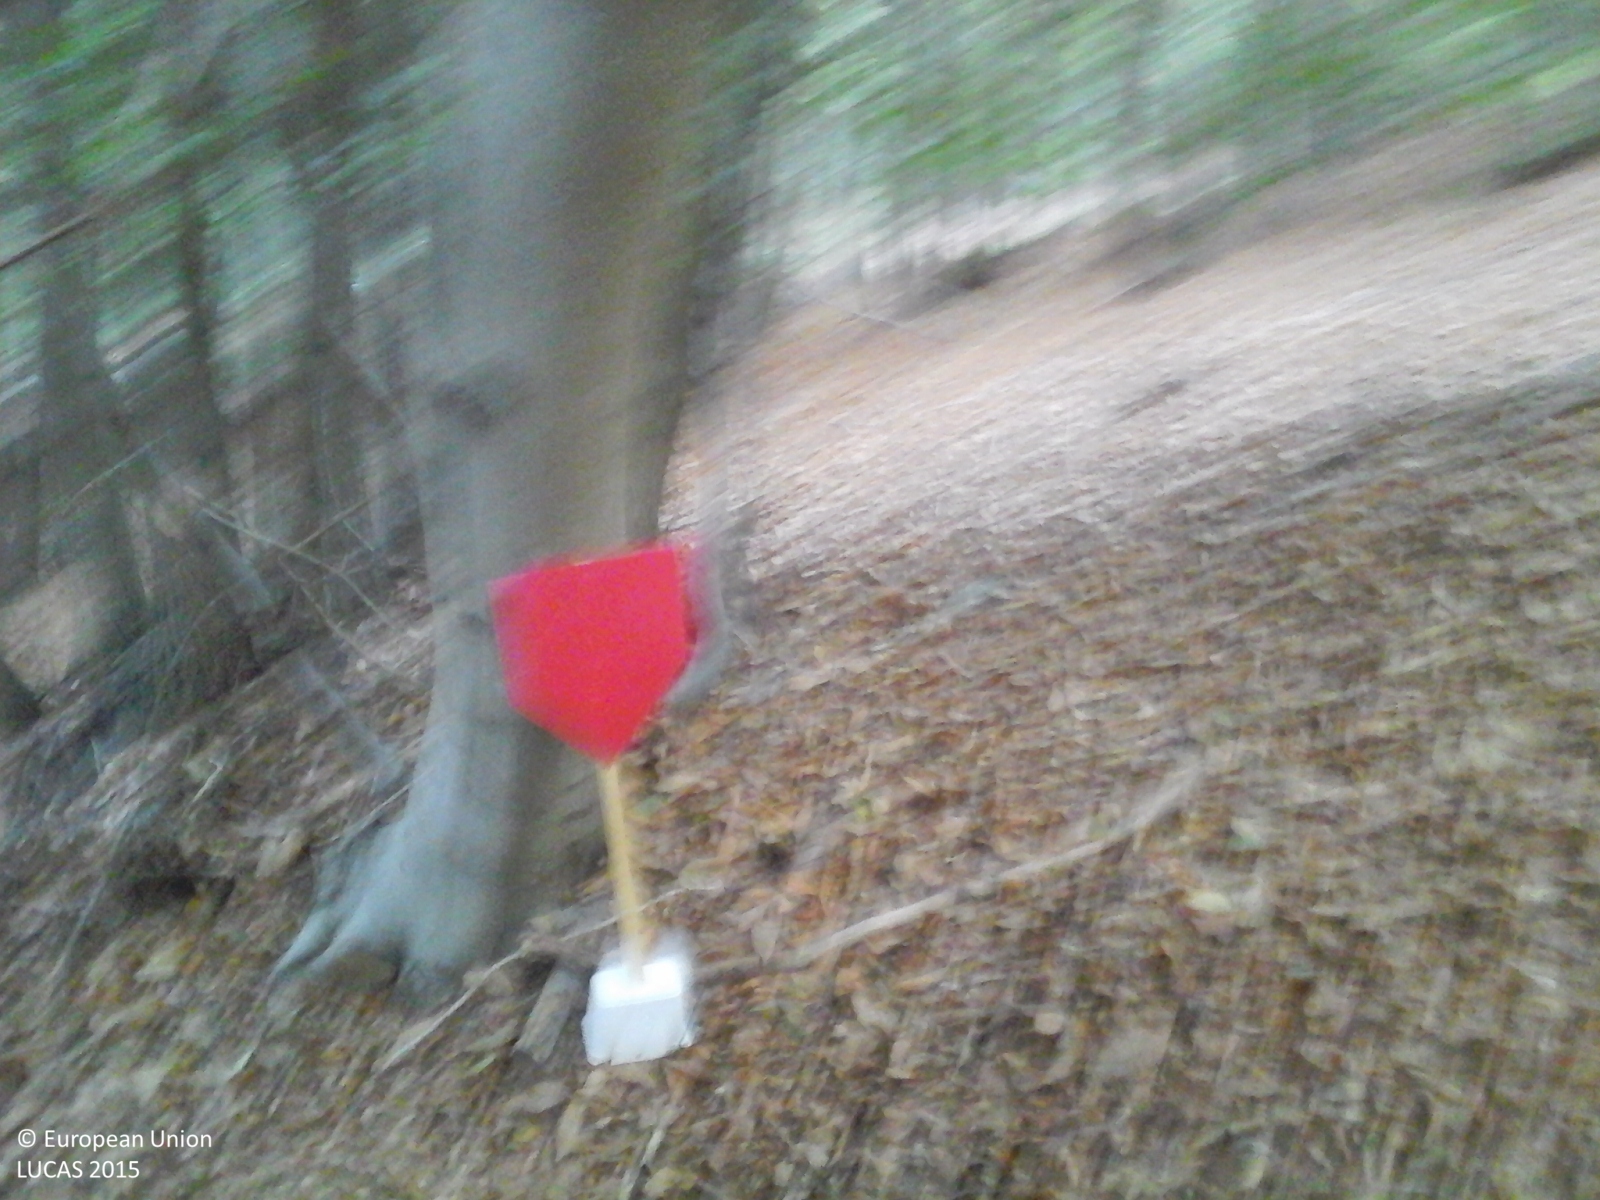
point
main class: Woodland
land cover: Broadleaved woodland
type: thermophilous deciduous forest
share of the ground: > 75 %
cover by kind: broadleaved forest trees 100 %
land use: Forestry
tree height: > 5 m
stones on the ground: 25 - 50 %
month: September
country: IT
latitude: 44.3192
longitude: 8.3362
